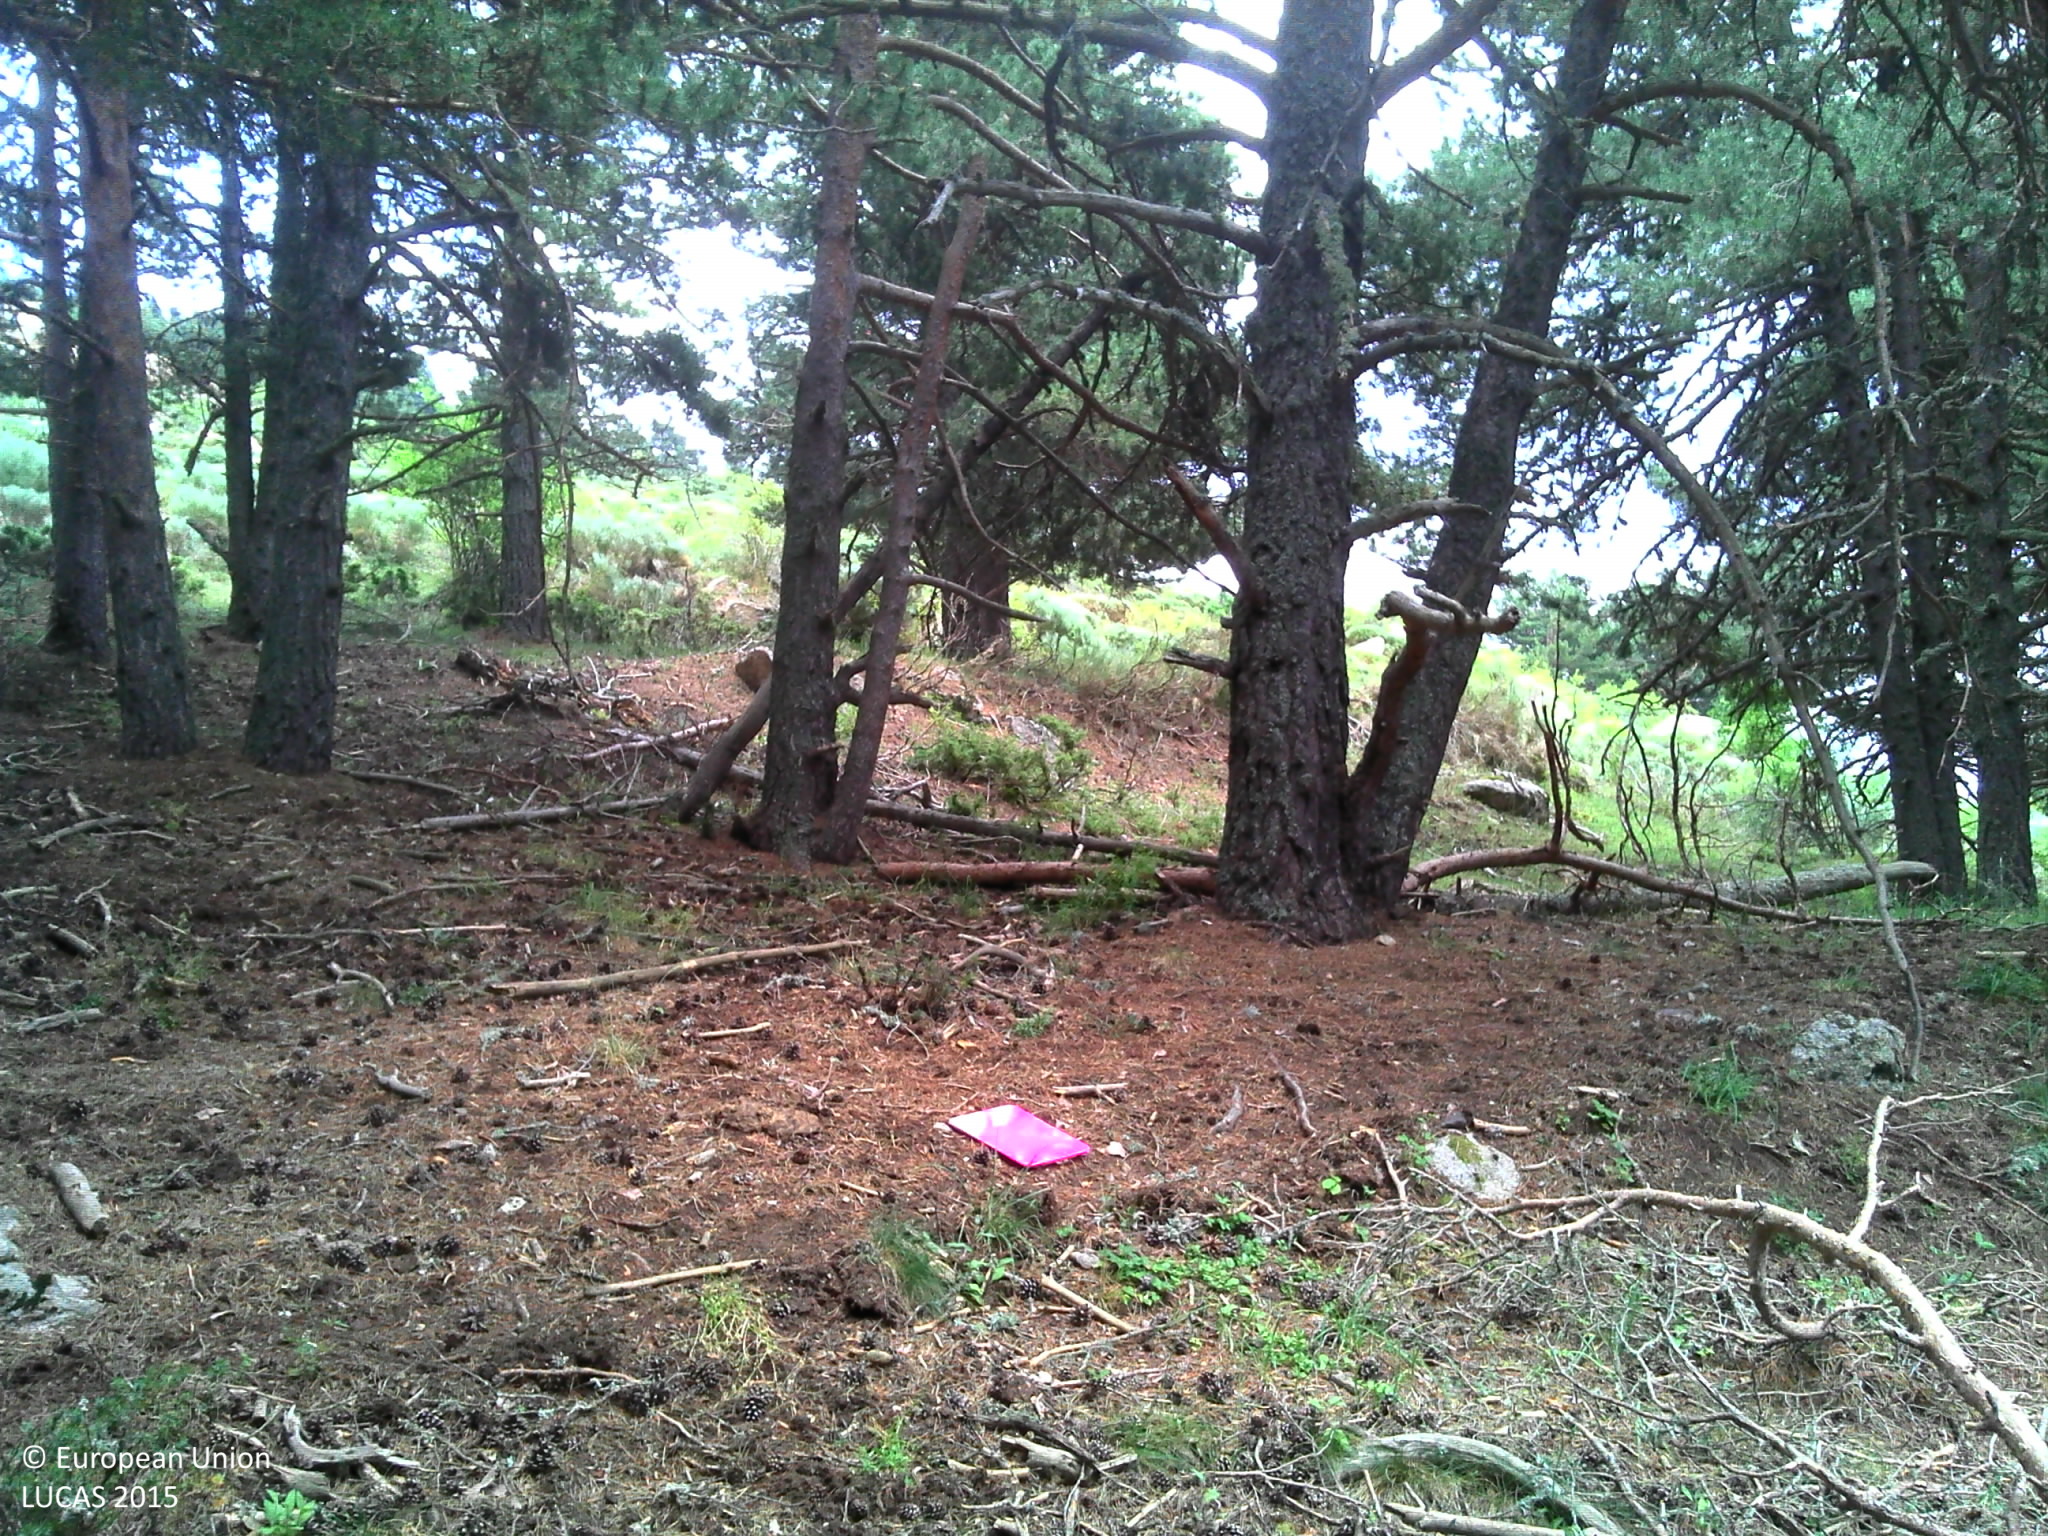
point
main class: Woodland
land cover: Pine dominated coniferous woodland
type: hemiboreal forest and nemoral coniferous forest and mixed broadleaved-coniferous forest
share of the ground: > 75 %
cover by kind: coniferous forest trees 80 %, shrubs 10 %, herbaceous plants 10 %
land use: Agriculture (excluding fallow land and kitchen gardens)
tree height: > 5 m
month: July
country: FR
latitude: 42.6029
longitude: 2.1492
